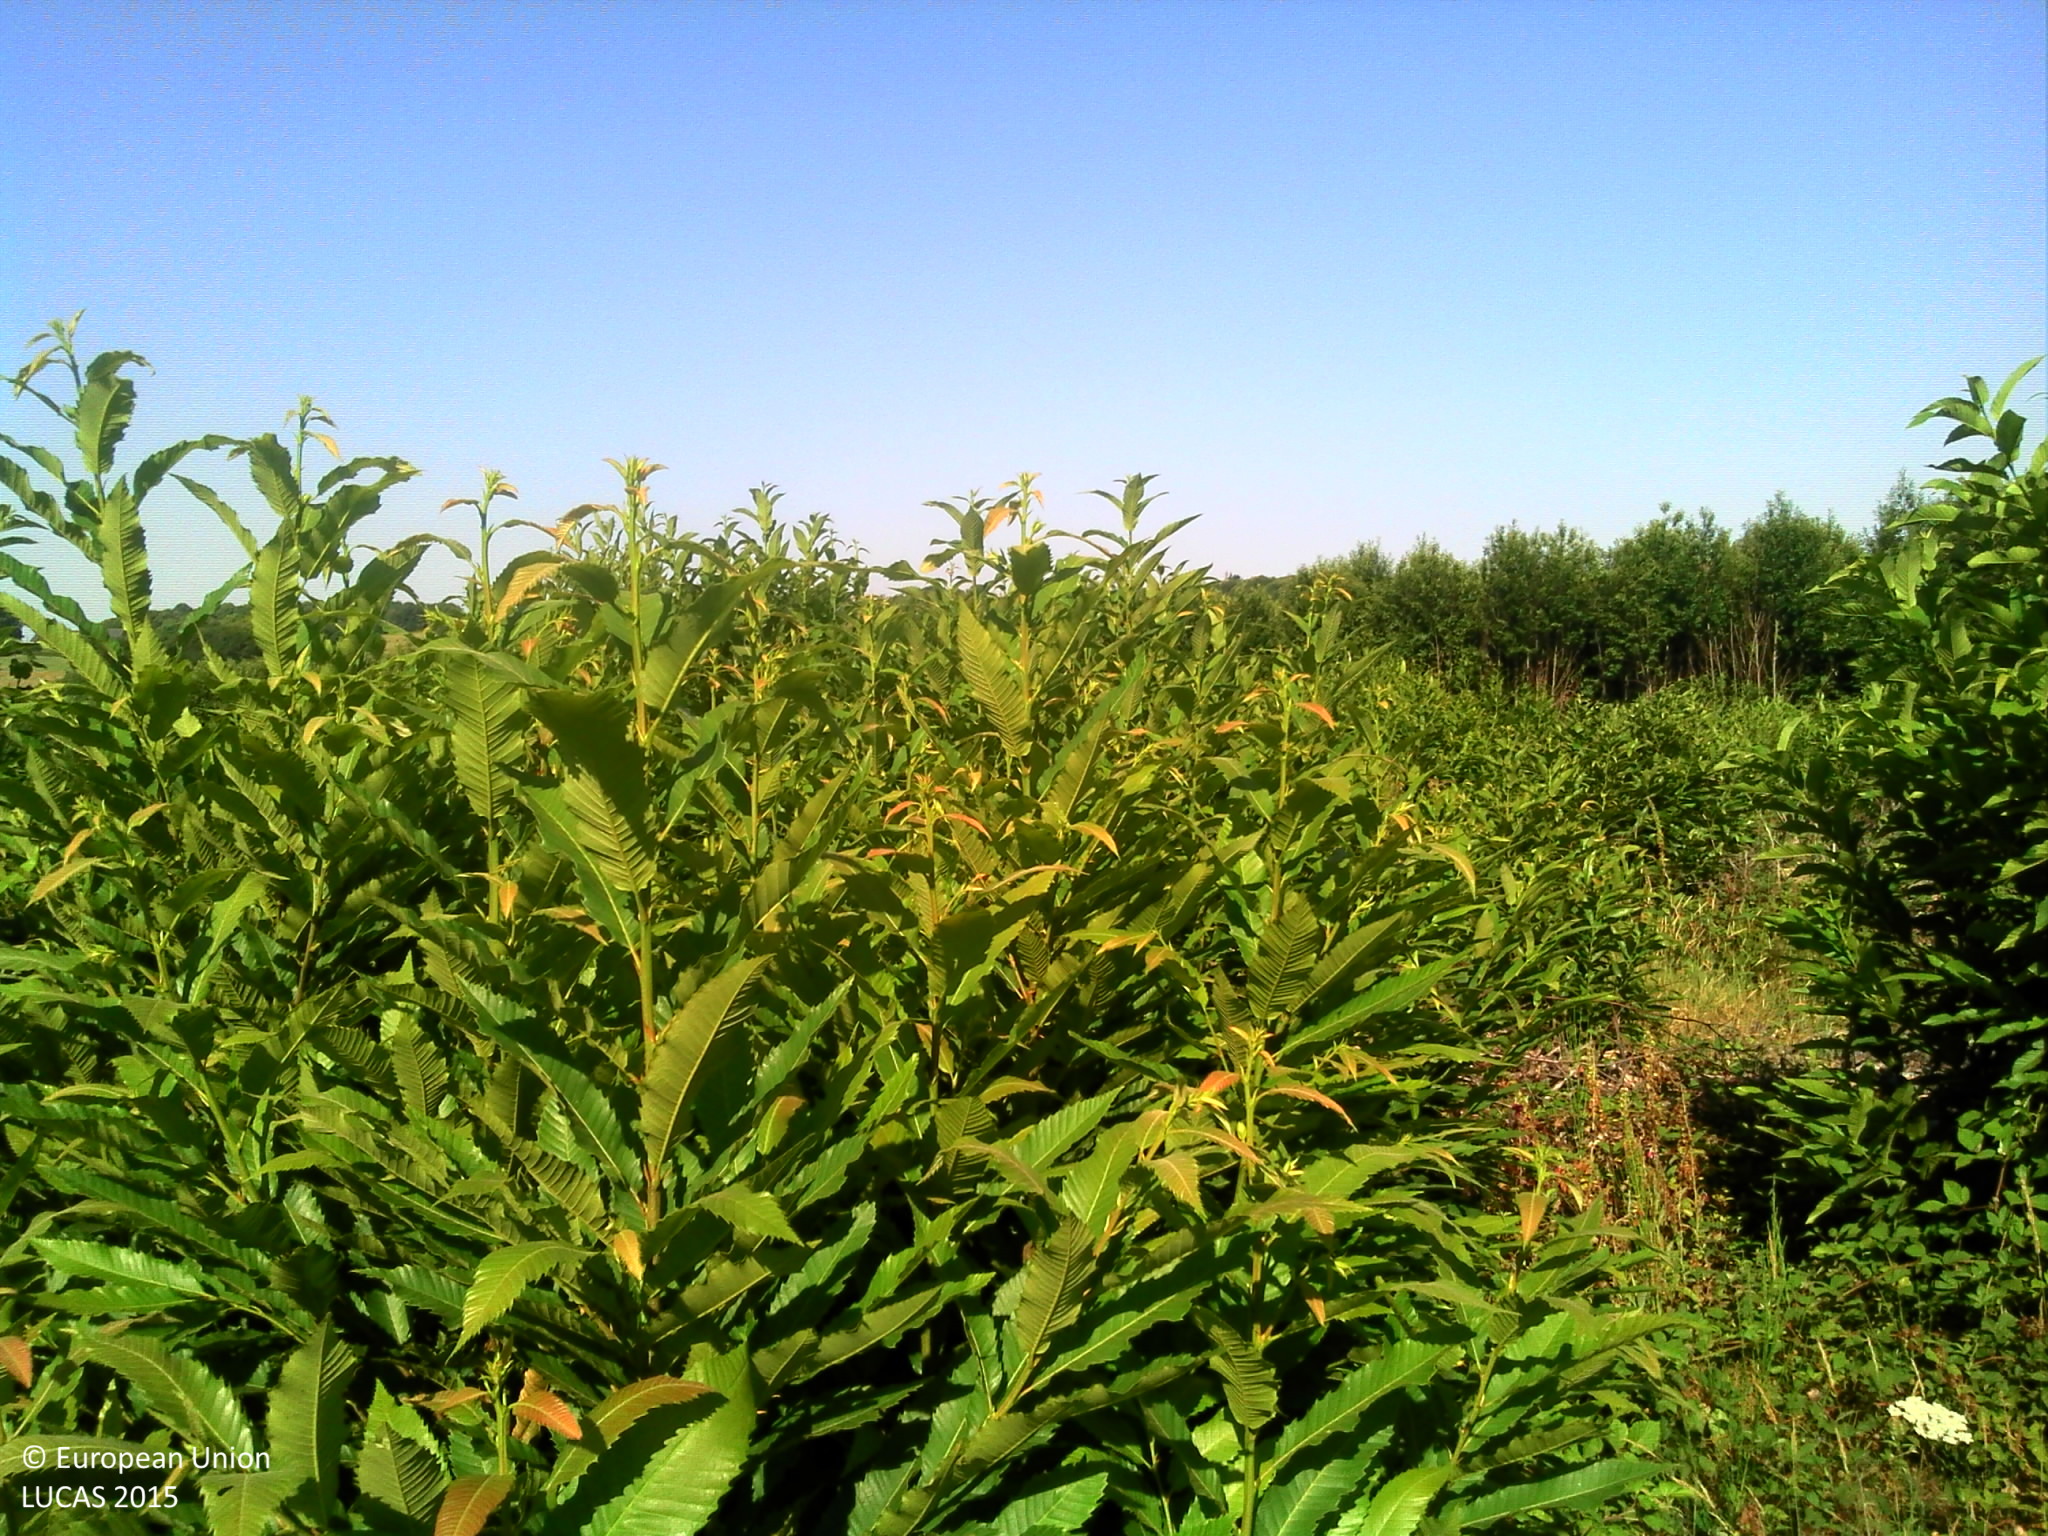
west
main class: Shrubland
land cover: Shrubland with sparse tree cover
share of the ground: > 75 %
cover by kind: shrubs 90 %, broadleaved forest trees 5 %, herbaceous plants 5 %
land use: Forestry
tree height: < 5 m
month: July
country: FR
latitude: 46.1999
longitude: 1.5808
